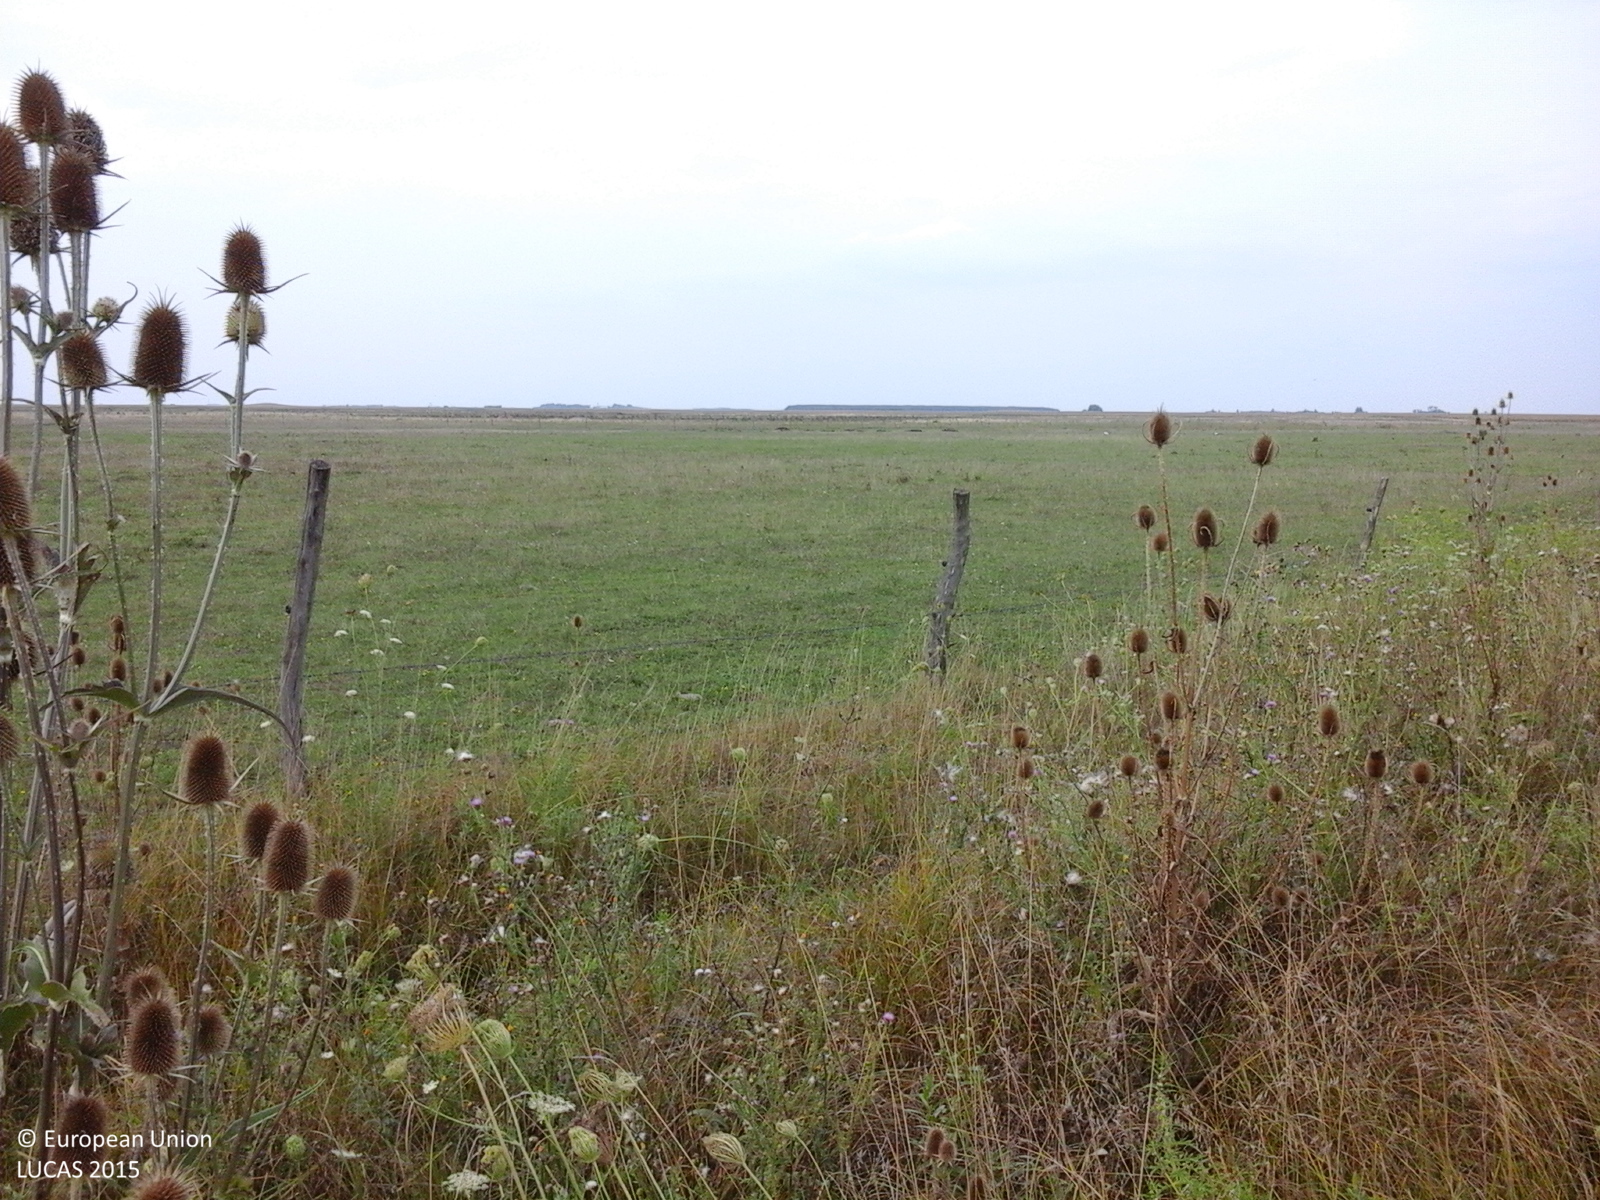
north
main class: Grassland
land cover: Grassland without tree/shrub cover
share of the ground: > 75 %
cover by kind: herbaceous plants 100 %
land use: Agriculture (excluding fallow land and kitchen gardens)
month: August
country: RO
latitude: 46.2748
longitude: 21.1536
